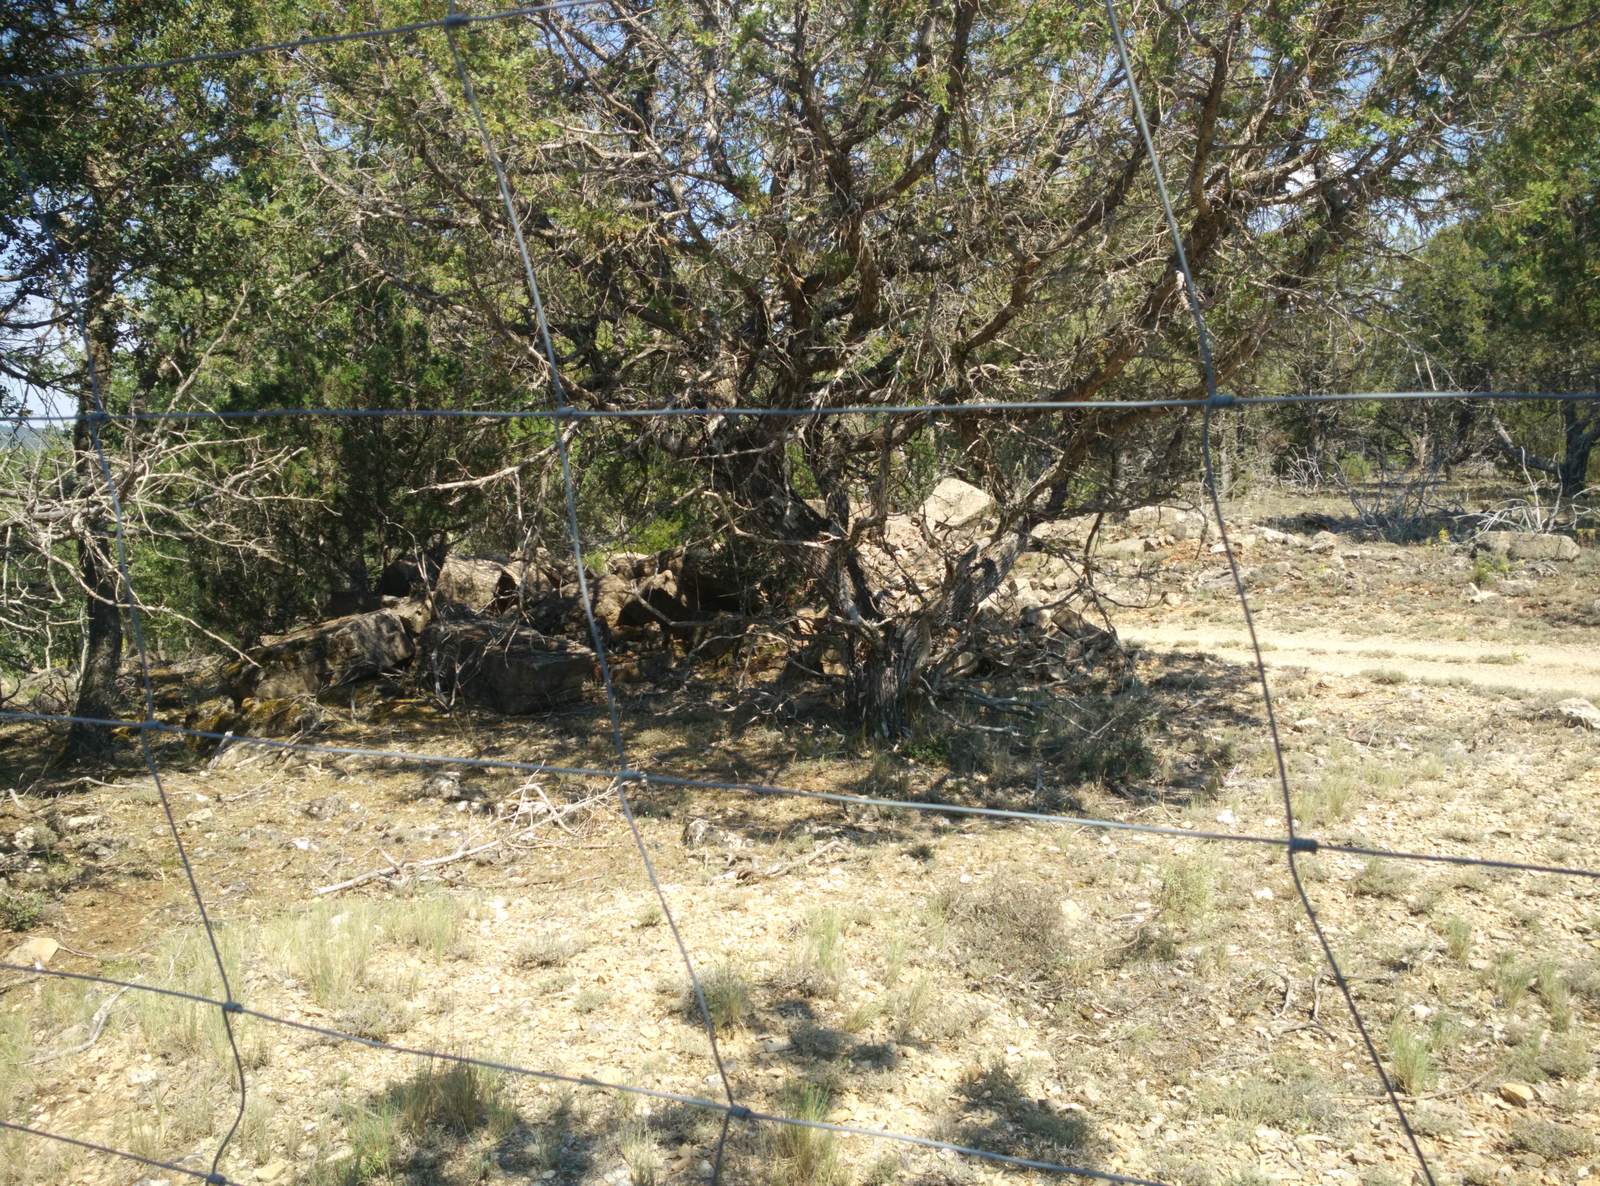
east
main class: Woodland
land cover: Pine dominated coniferous woodland
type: coniferous forest of the mediterranean region
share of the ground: 50 - 75 %
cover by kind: coniferous forest trees 50 %, unconsolidated bare surface 35 %, shrubs 10 %, broadleaved forest trees 5 %
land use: Semi-natural and natural areas not in use
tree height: > 5 m
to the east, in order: Pine dominated coniferous woodland
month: July
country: ES
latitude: 40.8476
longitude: -2.1109
